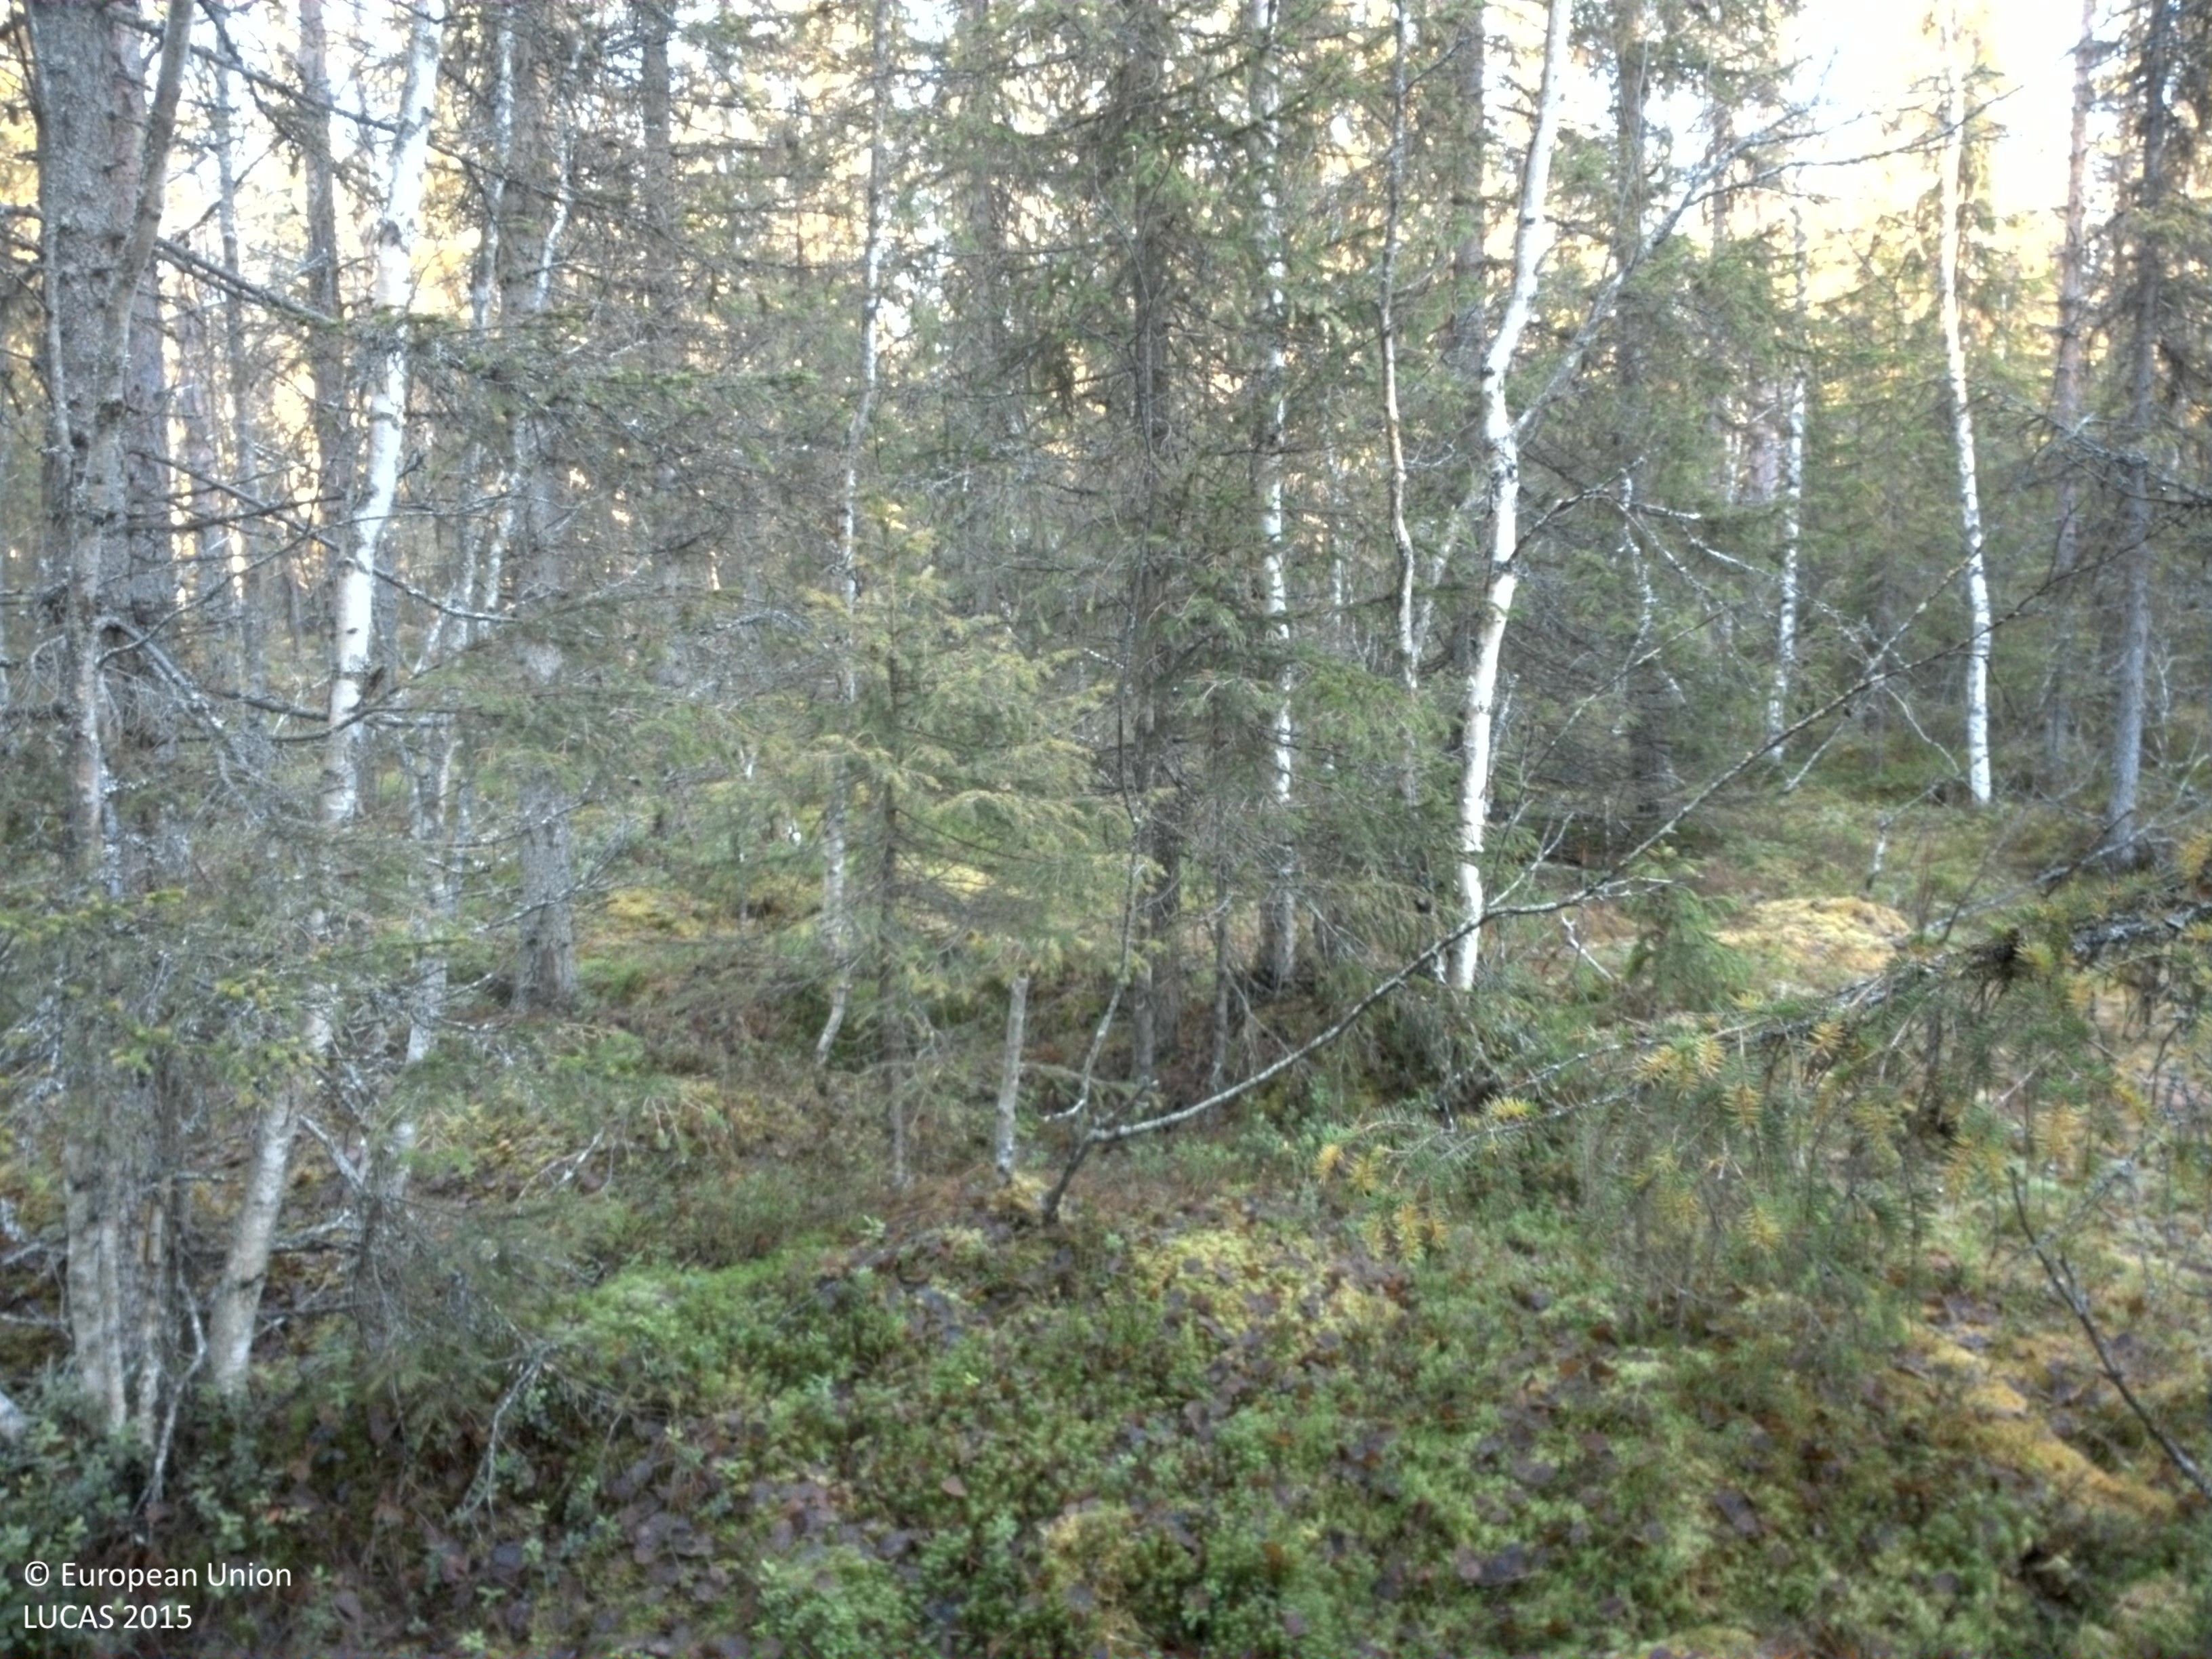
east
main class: Woodland
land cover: Spruce dominated mixed woodland
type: boreal forest
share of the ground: 25 - 50 %
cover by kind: coniferous forest trees 30 %, lichens and mosses 30 %, shrubs 25 %, broadleaved forest trees 10 %, herbaceous plants 5 %
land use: Forestry
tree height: > 5 m
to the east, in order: Spruce dominated mixed woodland; Other mixed woodland; Spruce dominated coniferous woodland; Grassland with sparse tree/shrub cover; Paved roads, cycling and walking lanes; Grass margins; Ditches and canals; Pine dominated coniferous woodland
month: October
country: SE
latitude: 64.4840
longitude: 16.8960
